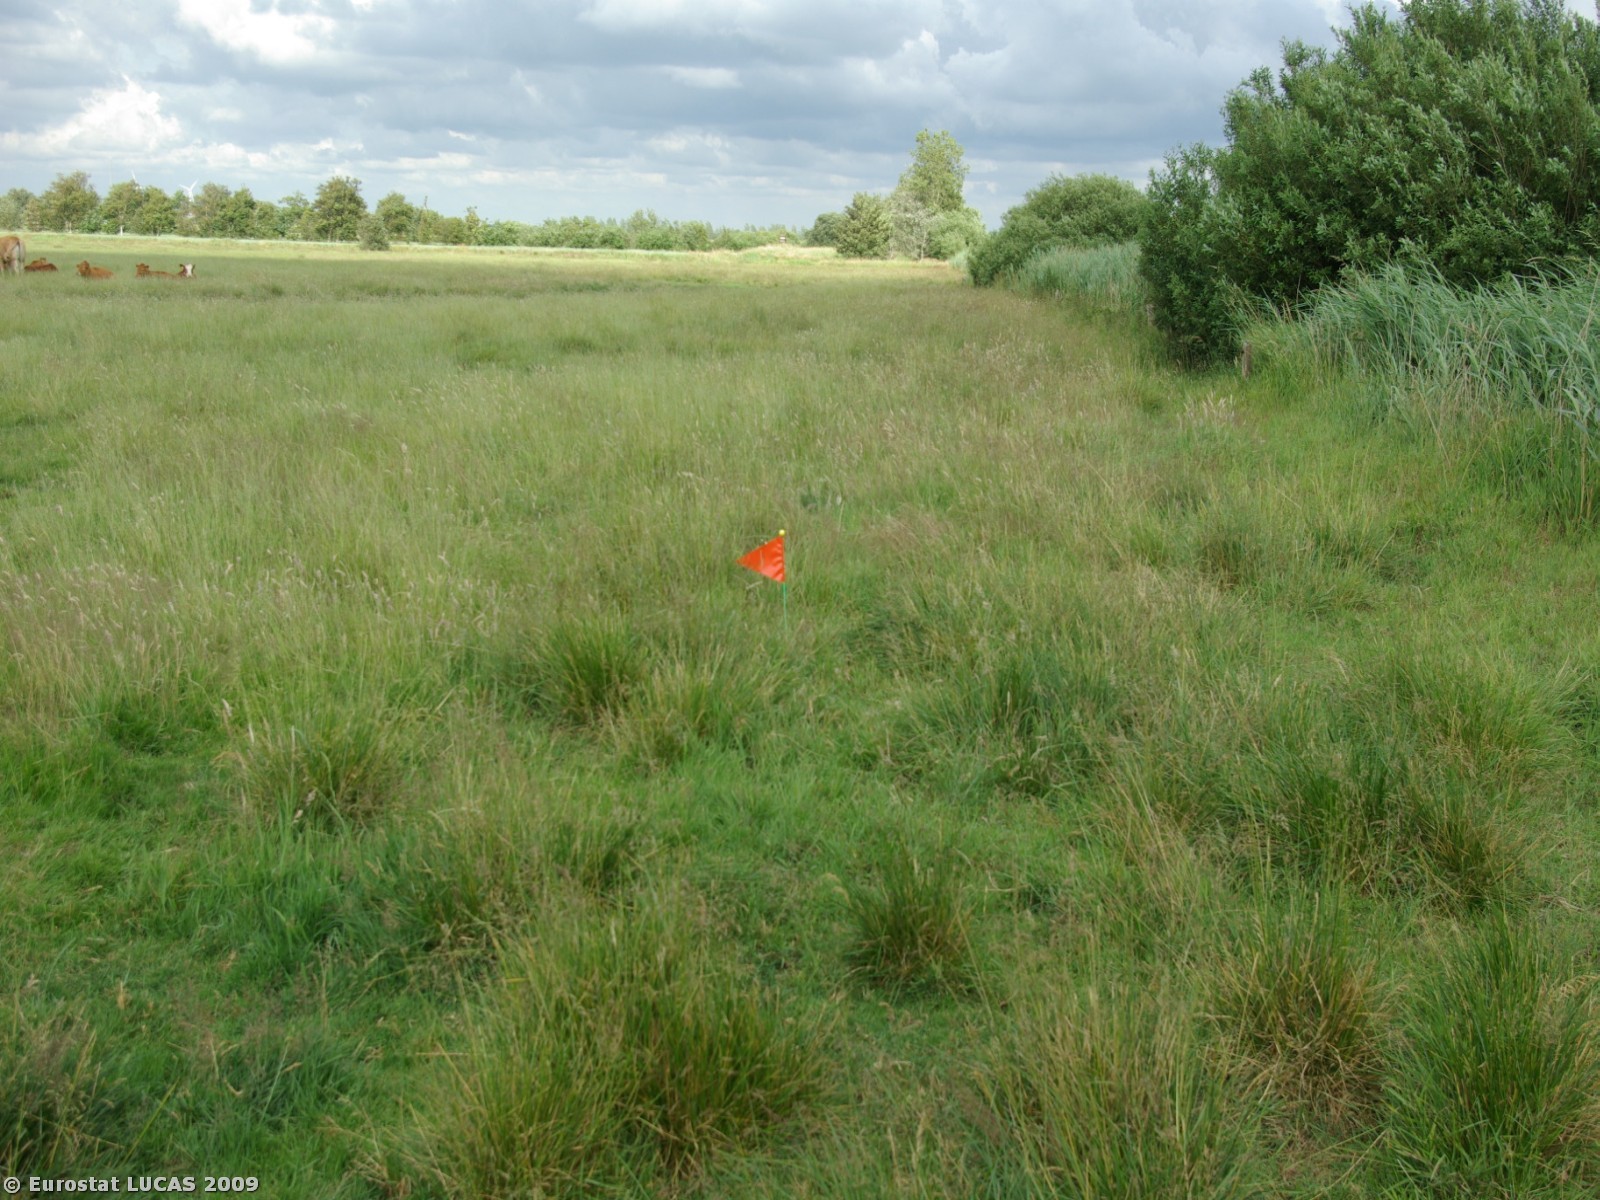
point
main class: Grassland
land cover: Grassland without tree/shrub cover
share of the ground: > 75 %
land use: Agriculture (excluding fallow land and kitchen gardens)
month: July
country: DK
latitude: 54.9247
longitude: 8.8930
